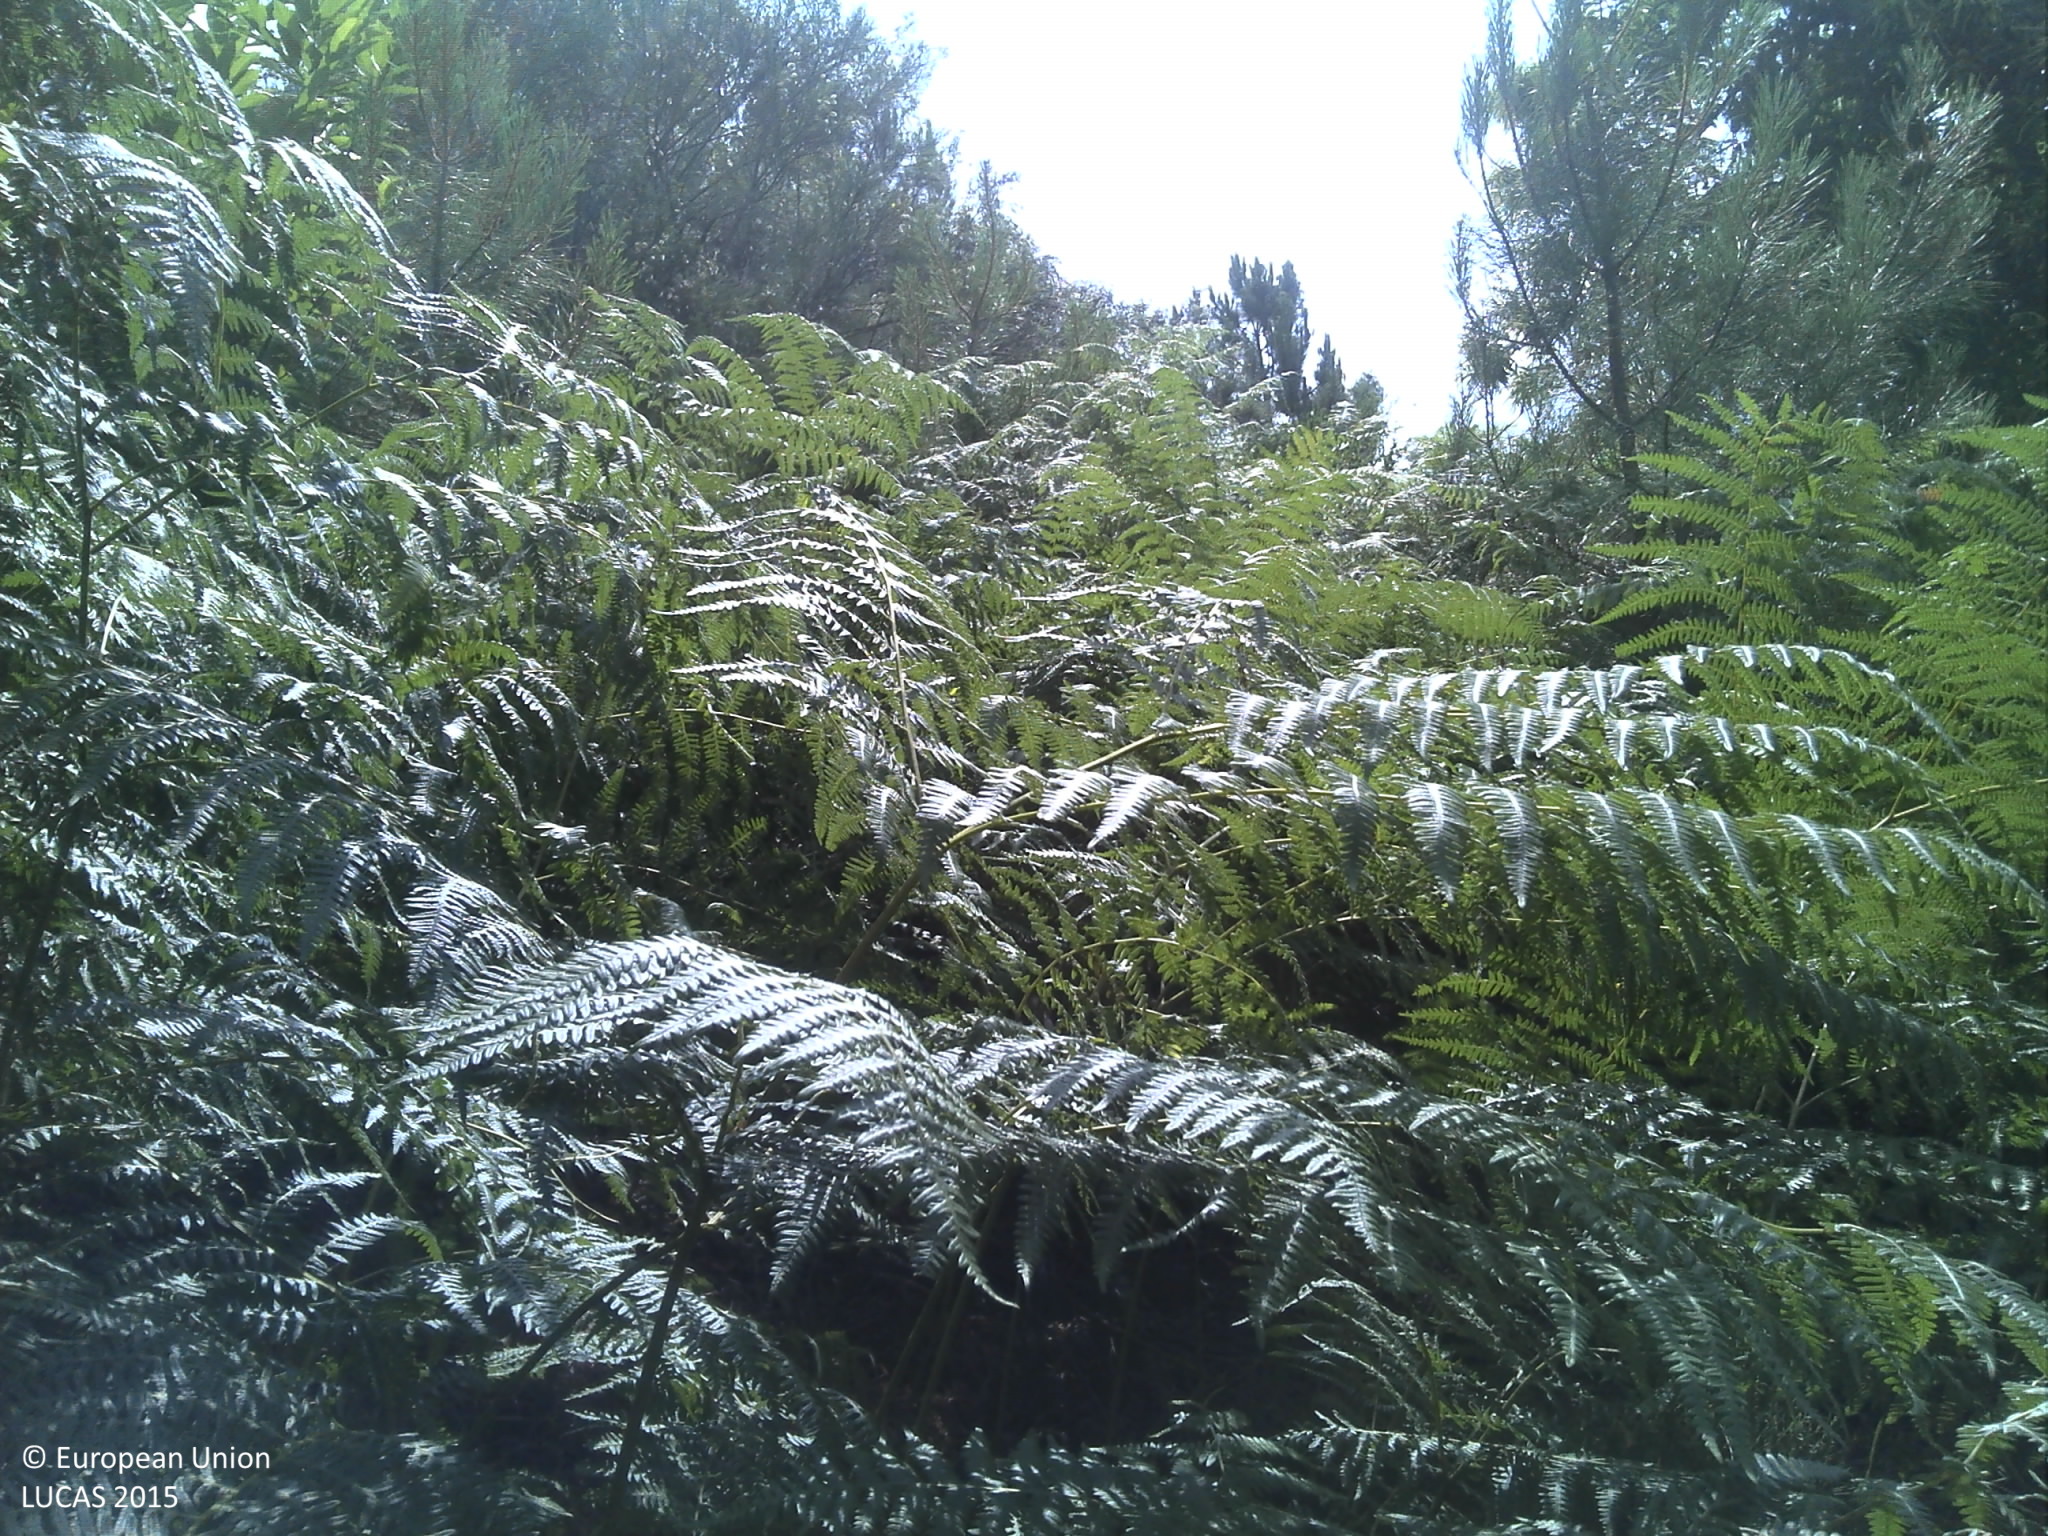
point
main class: Woodland
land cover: Pine dominated mixed woodland
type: coniferous forest of the mediterranean region
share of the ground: 50 - 75 %
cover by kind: coniferous forest trees 50 %, broadleaved forest trees 25 %, shrubs 20 %
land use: Forestry
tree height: > 5 m
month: June
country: PT
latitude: 40.2237
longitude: -7.4385
